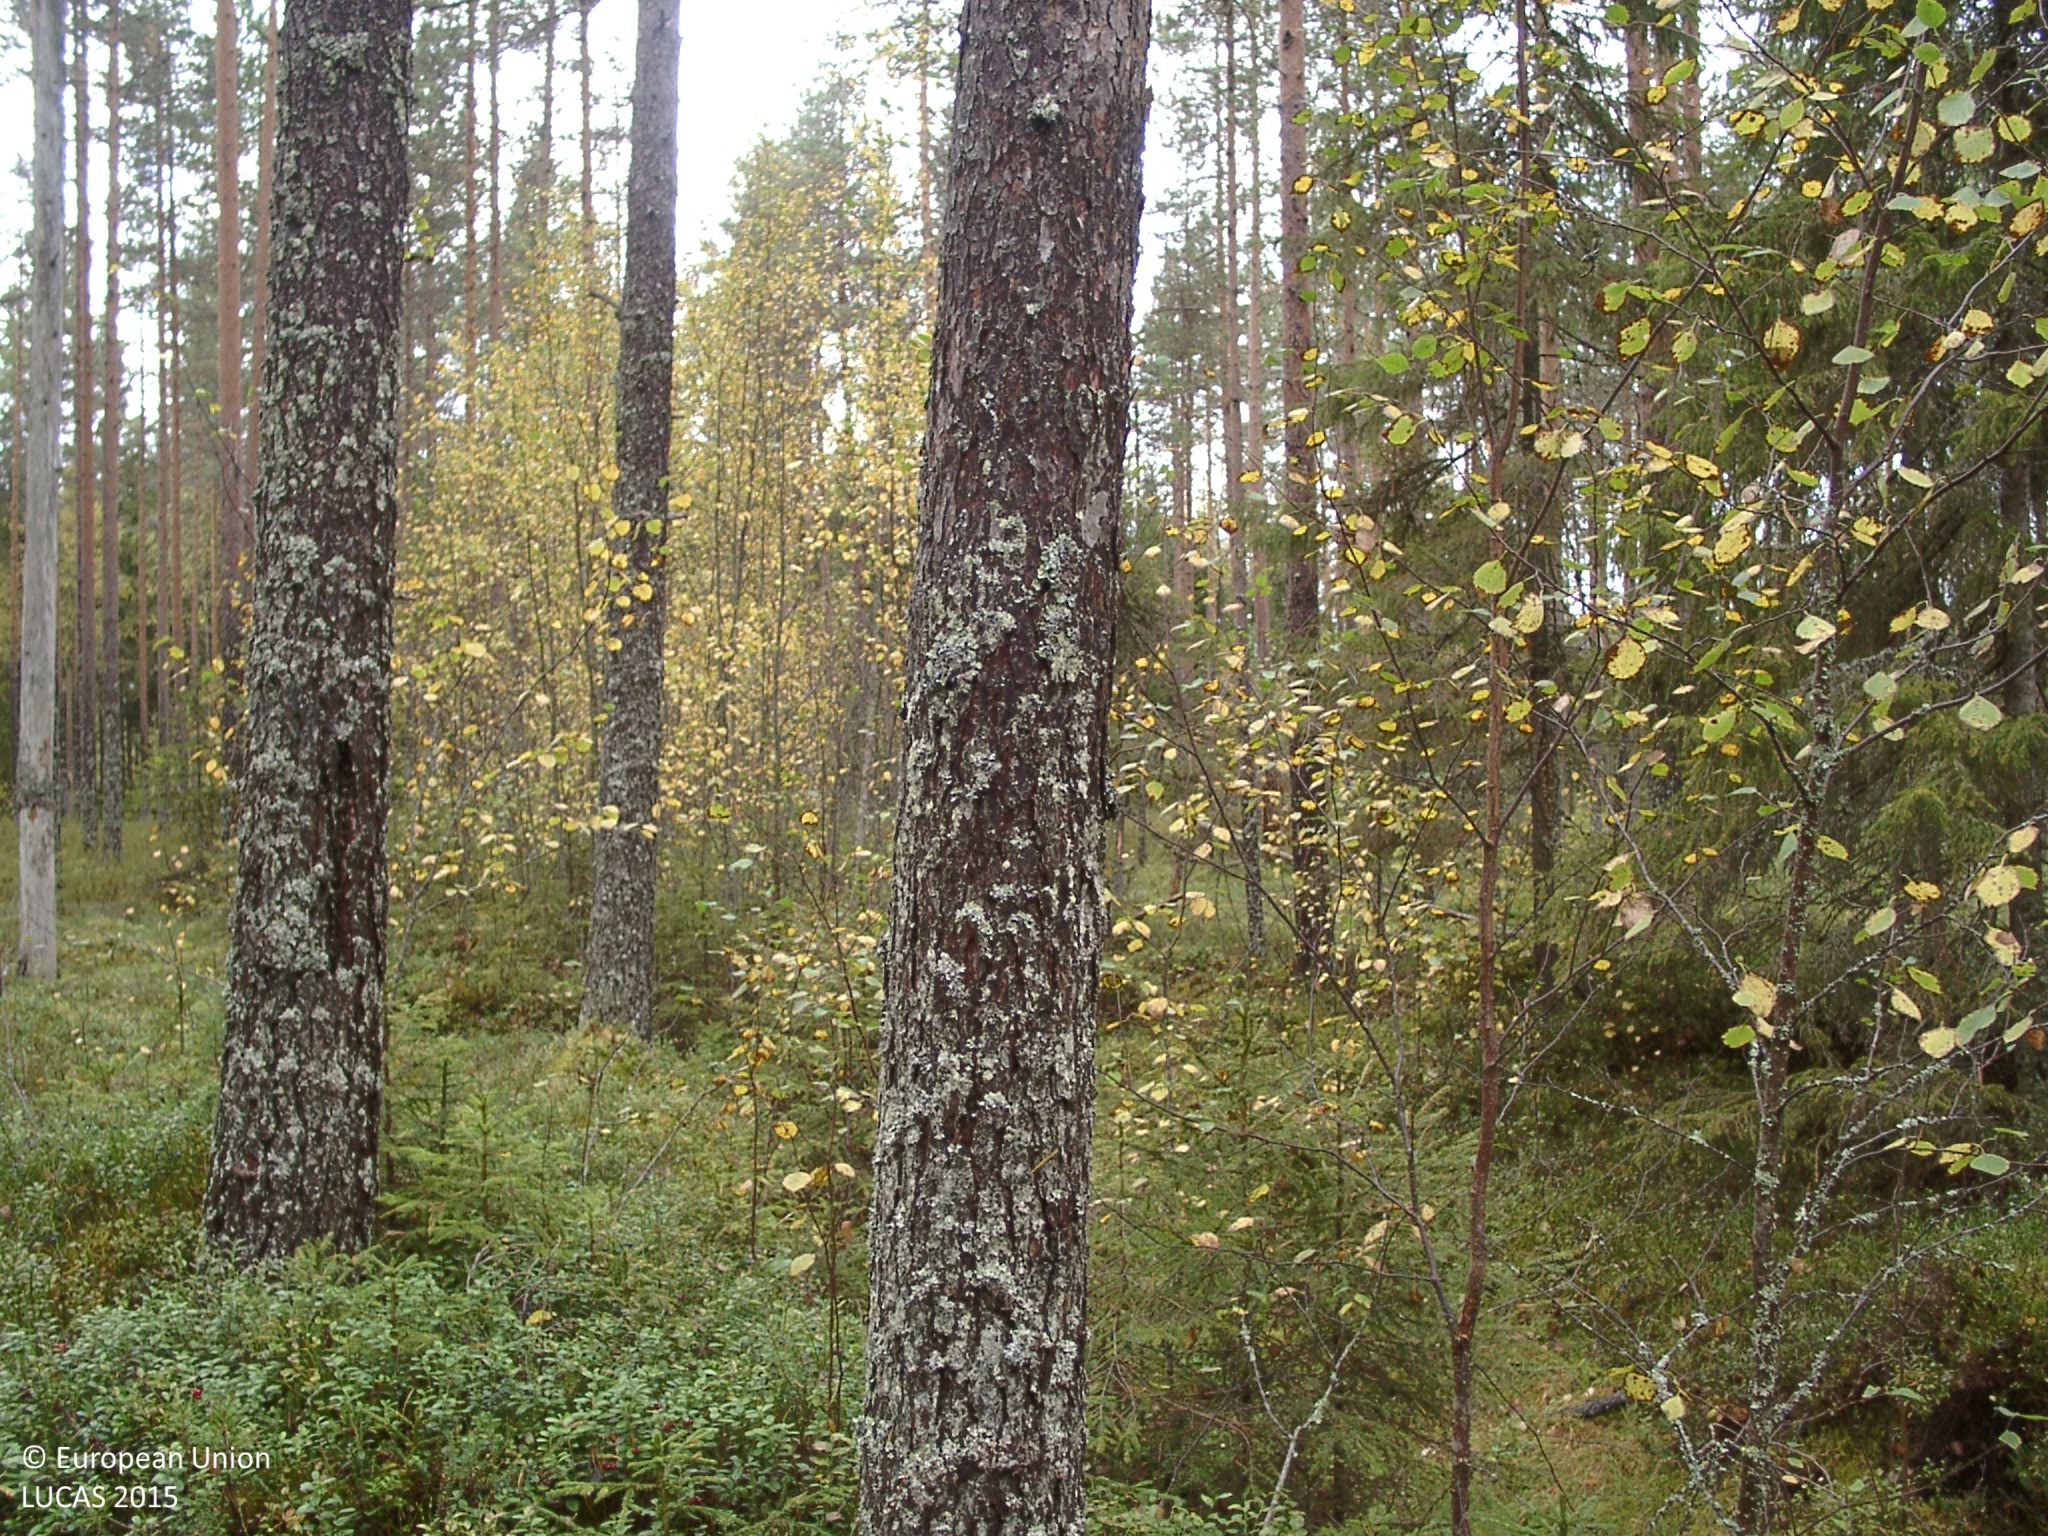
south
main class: Woodland
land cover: Other mixed woodland
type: mire and swamp forests
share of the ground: 50 - 75 %
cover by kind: coniferous forest trees 45 %, shrubs 25 %, broadleaved forest trees 15 %, lichens and mosses 10 %, herbaceous plants 5 %
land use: Forestry
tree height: > 5 m
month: September
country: FI
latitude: 62.5046
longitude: 25.3096
